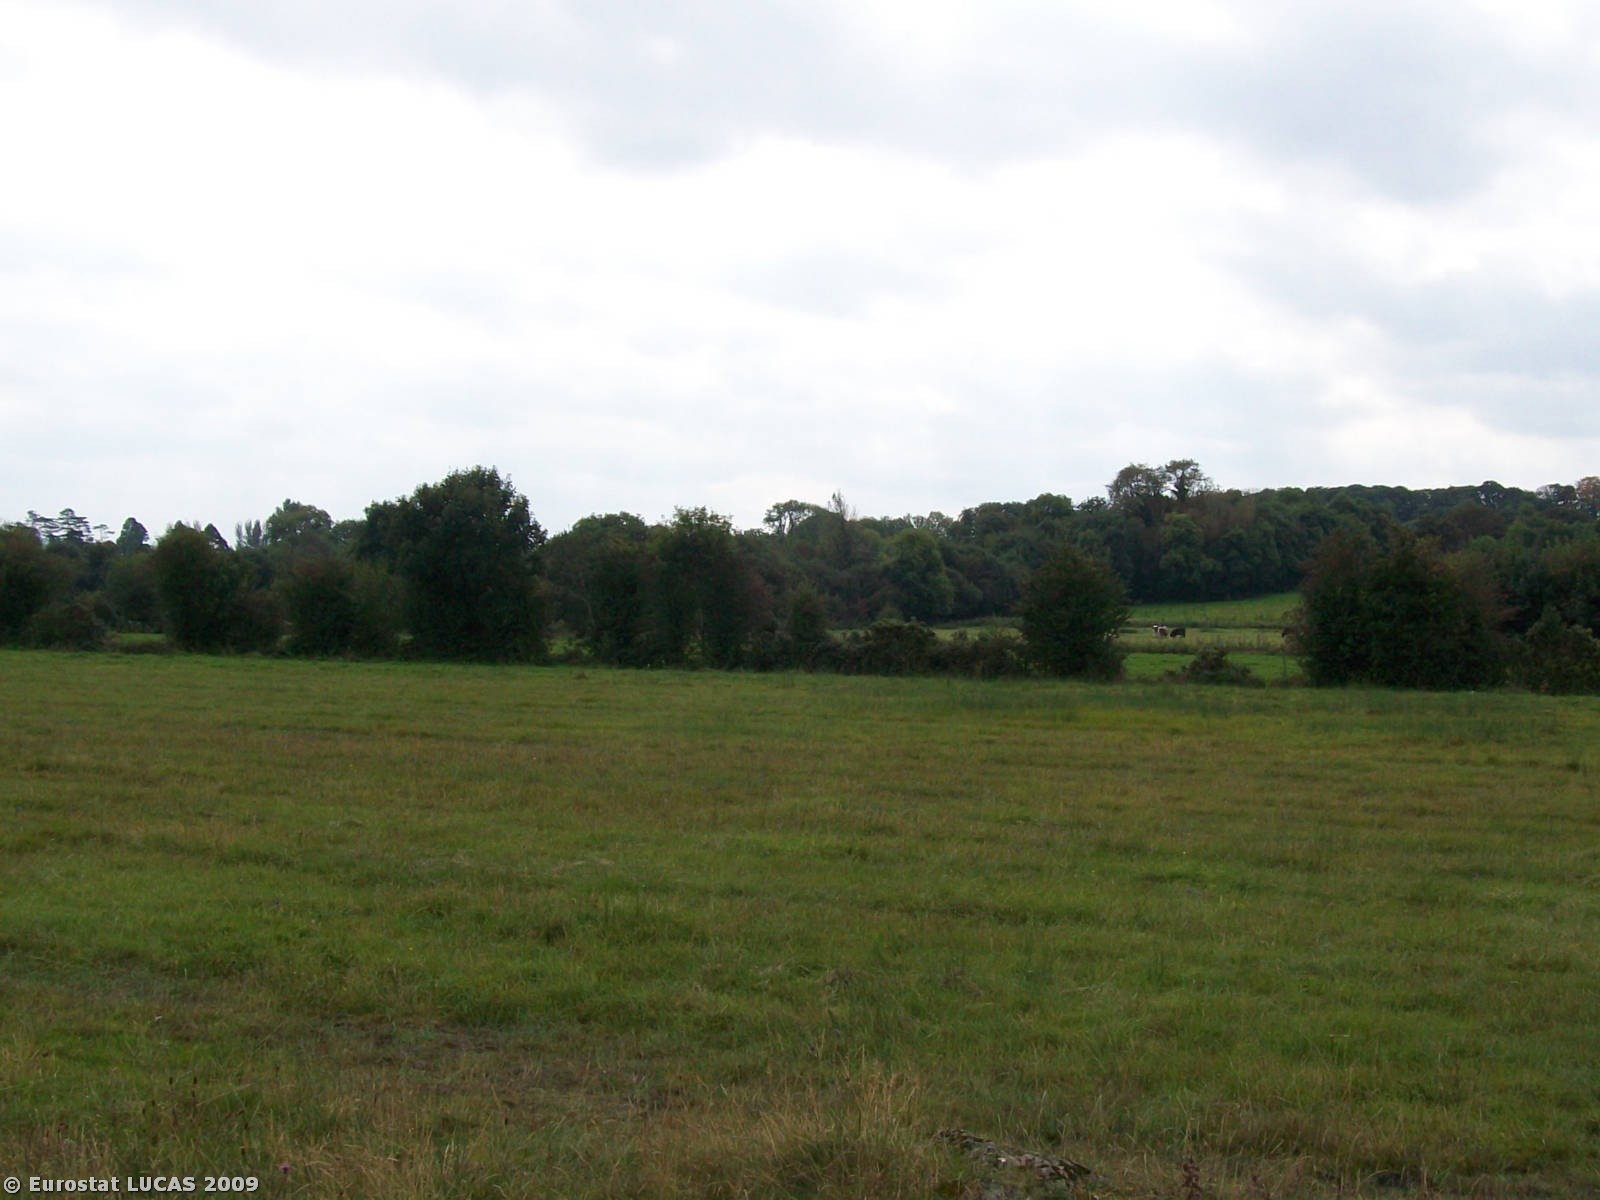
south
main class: Grassland
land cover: Grassland without tree/shrub cover
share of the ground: > 75 %
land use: Agriculture (excluding fallow land and kitchen gardens)
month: September
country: IE
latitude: 52.9599
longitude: -7.8717
